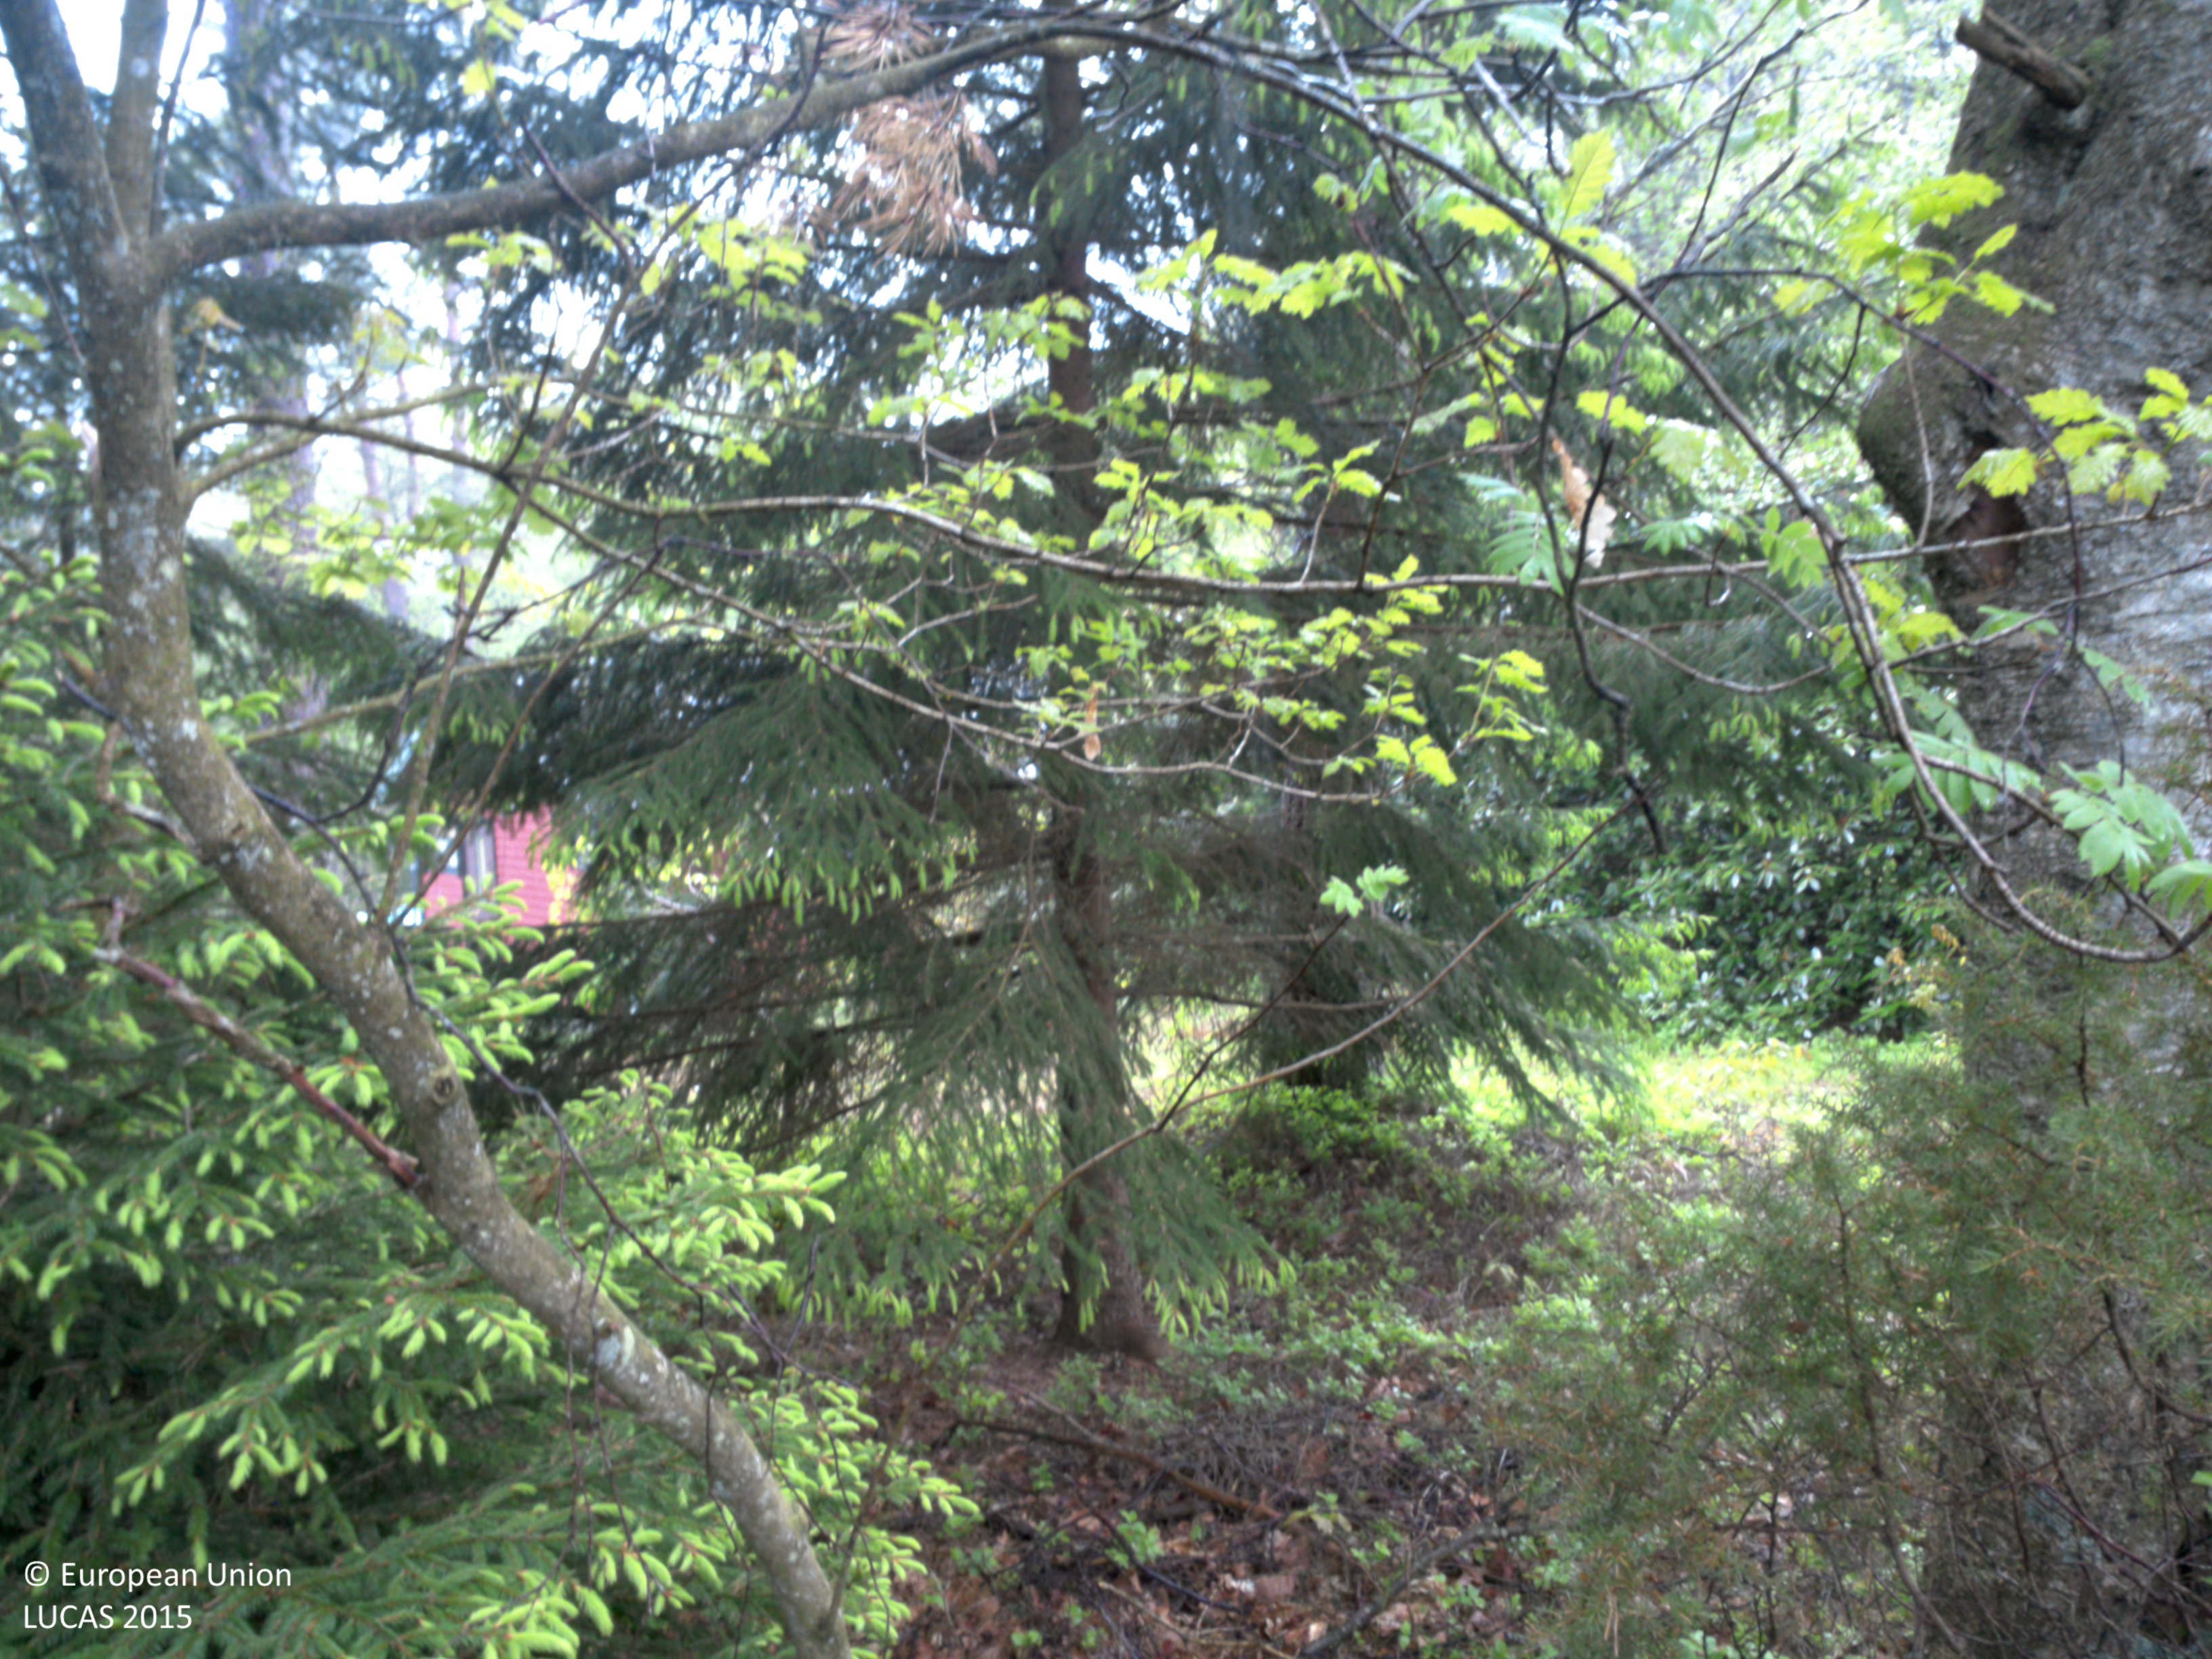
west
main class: Woodland
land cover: Pine dominated mixed woodland
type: boreal forest
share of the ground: 50 - 75 %
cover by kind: coniferous forest trees 50 %, broadleaved forest trees 25 %, herbaceous plants 15 %, shrubs 10 %
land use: Amenities, museums, leisure
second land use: Residential
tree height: > 5 m
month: June
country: SE
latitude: 57.8596
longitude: 12.2040
